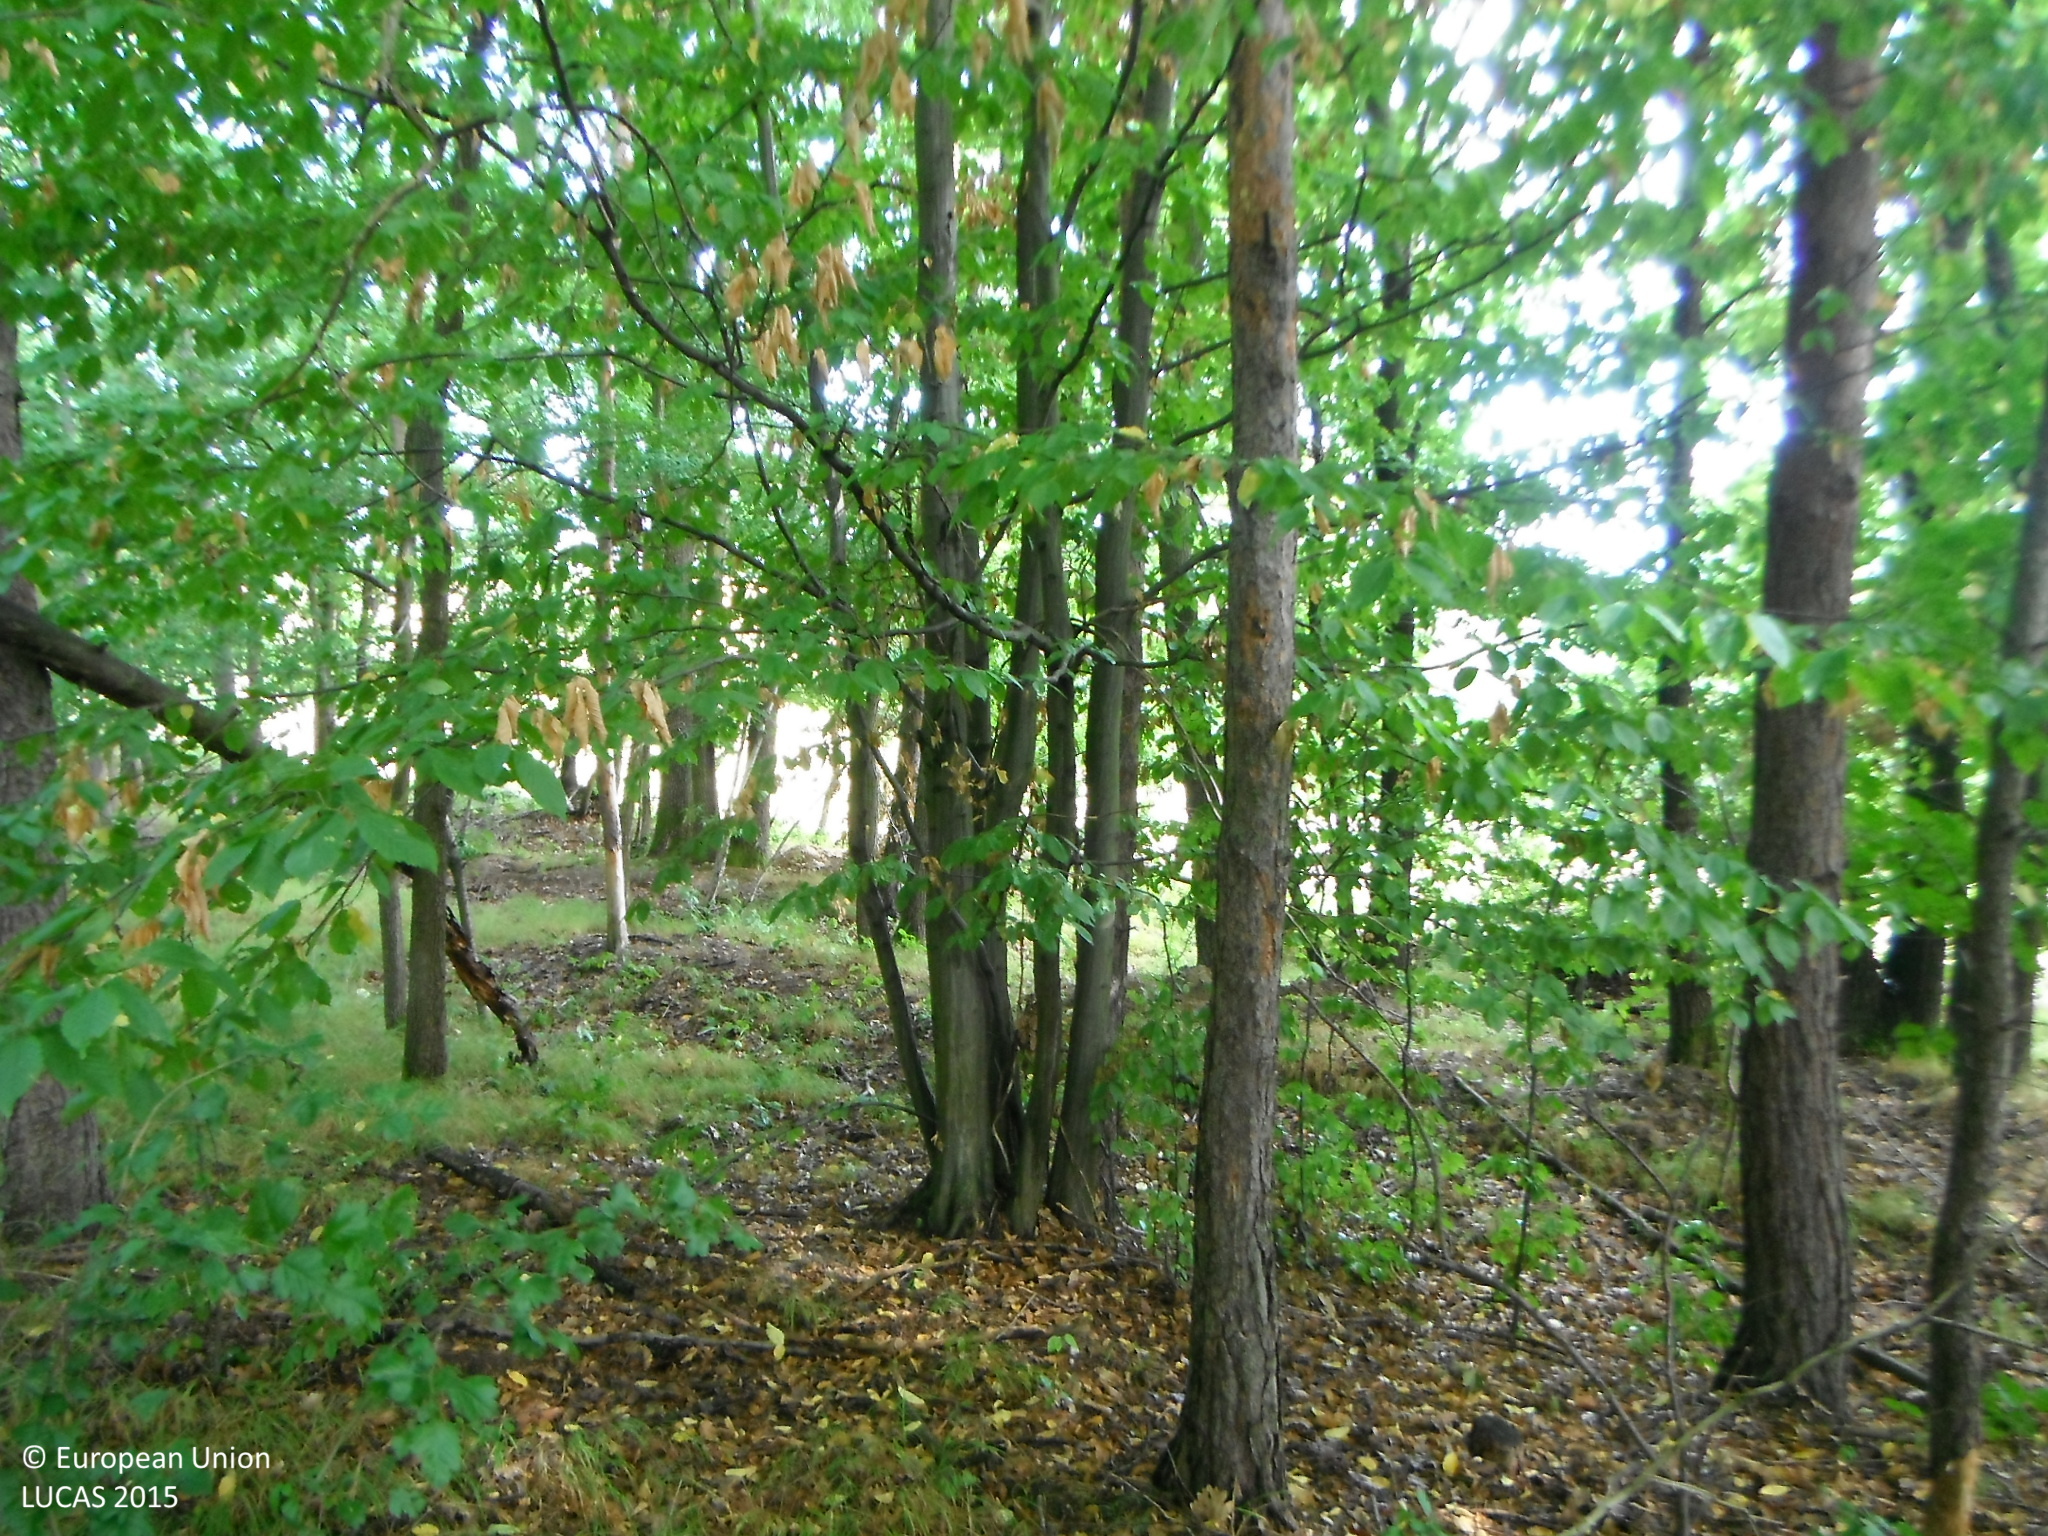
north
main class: Woodland
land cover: Other mixed woodland
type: hemiboreal forest and nemoral coniferous forest and mixed broadleaved-coniferous forest
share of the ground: > 75 %
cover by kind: coniferous forest trees 60 %, broadleaved forest trees 40 %
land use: Forestry
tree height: > 5 m
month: July
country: SK
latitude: 48.7582
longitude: 18.3276
